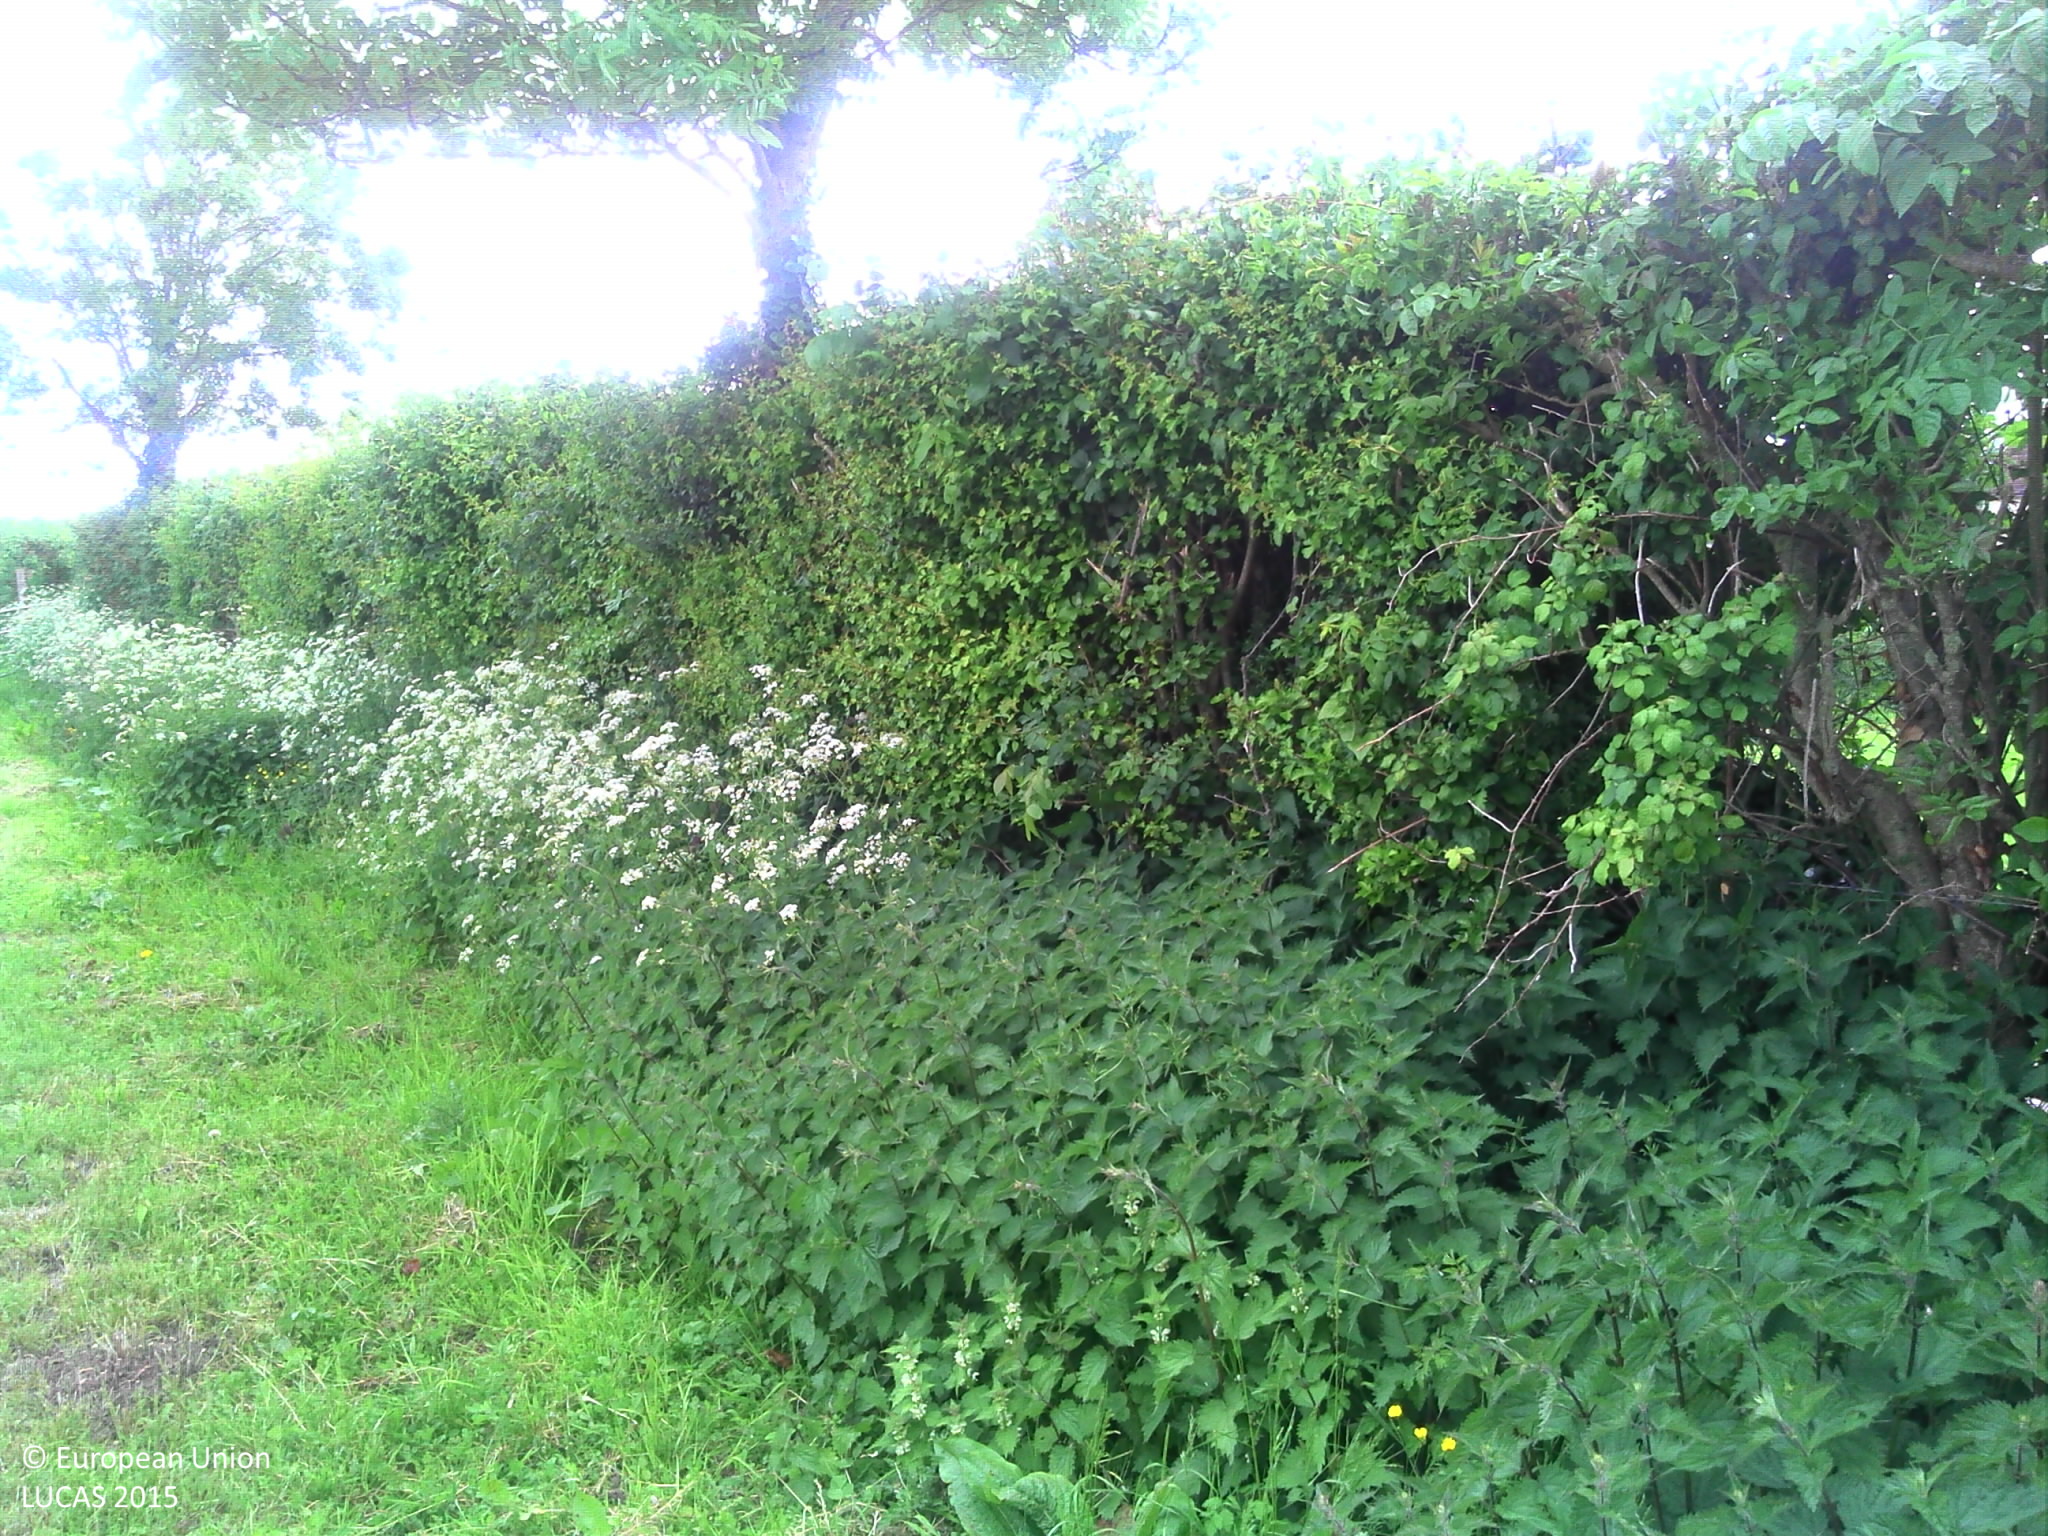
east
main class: Grassland
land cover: Grassland without tree/shrub cover
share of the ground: > 75 %
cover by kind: herbaceous plants 100 %
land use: Agriculture (excluding fallow land and kitchen gardens)
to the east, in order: Grassland without tree/shrub cover; Managed hedges; Artificial constructions in urban areas; Grassland without tree/shrub cover
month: May
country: FR
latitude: 48.7879
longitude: -0.1448
